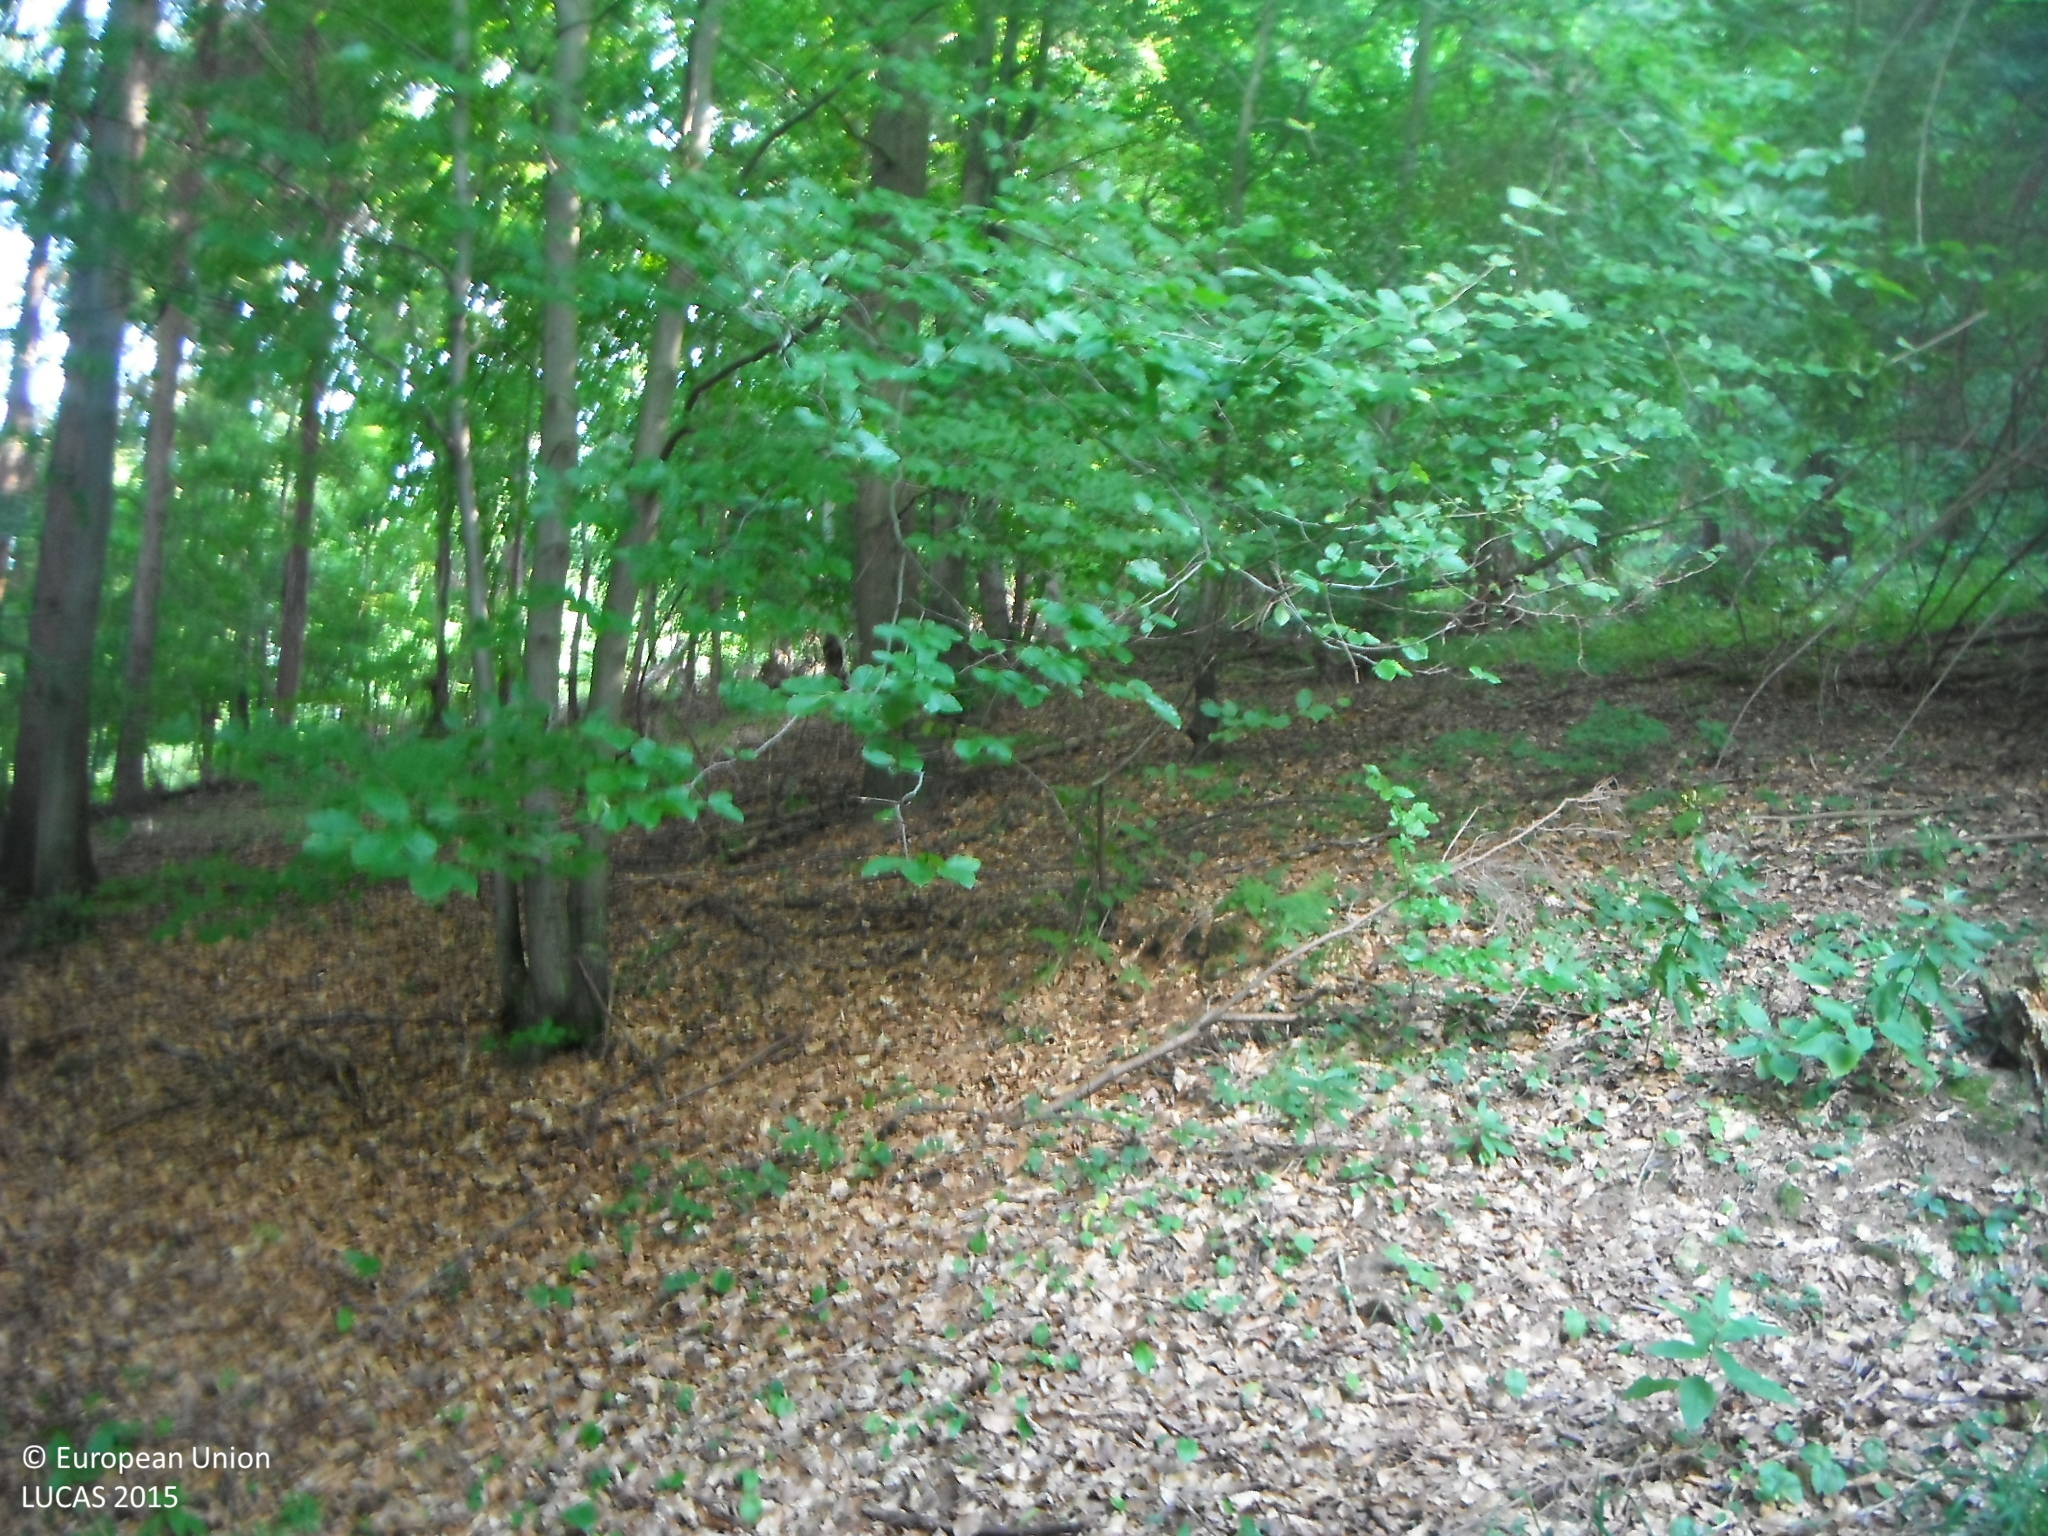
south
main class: Woodland
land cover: Broadleaved woodland
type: mesophytic deciduous forest
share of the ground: > 75 %
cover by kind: broadleaved forest trees 100 %
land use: Forestry
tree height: > 5 m
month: August
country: SK
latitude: 48.8768
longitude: 20.7422
